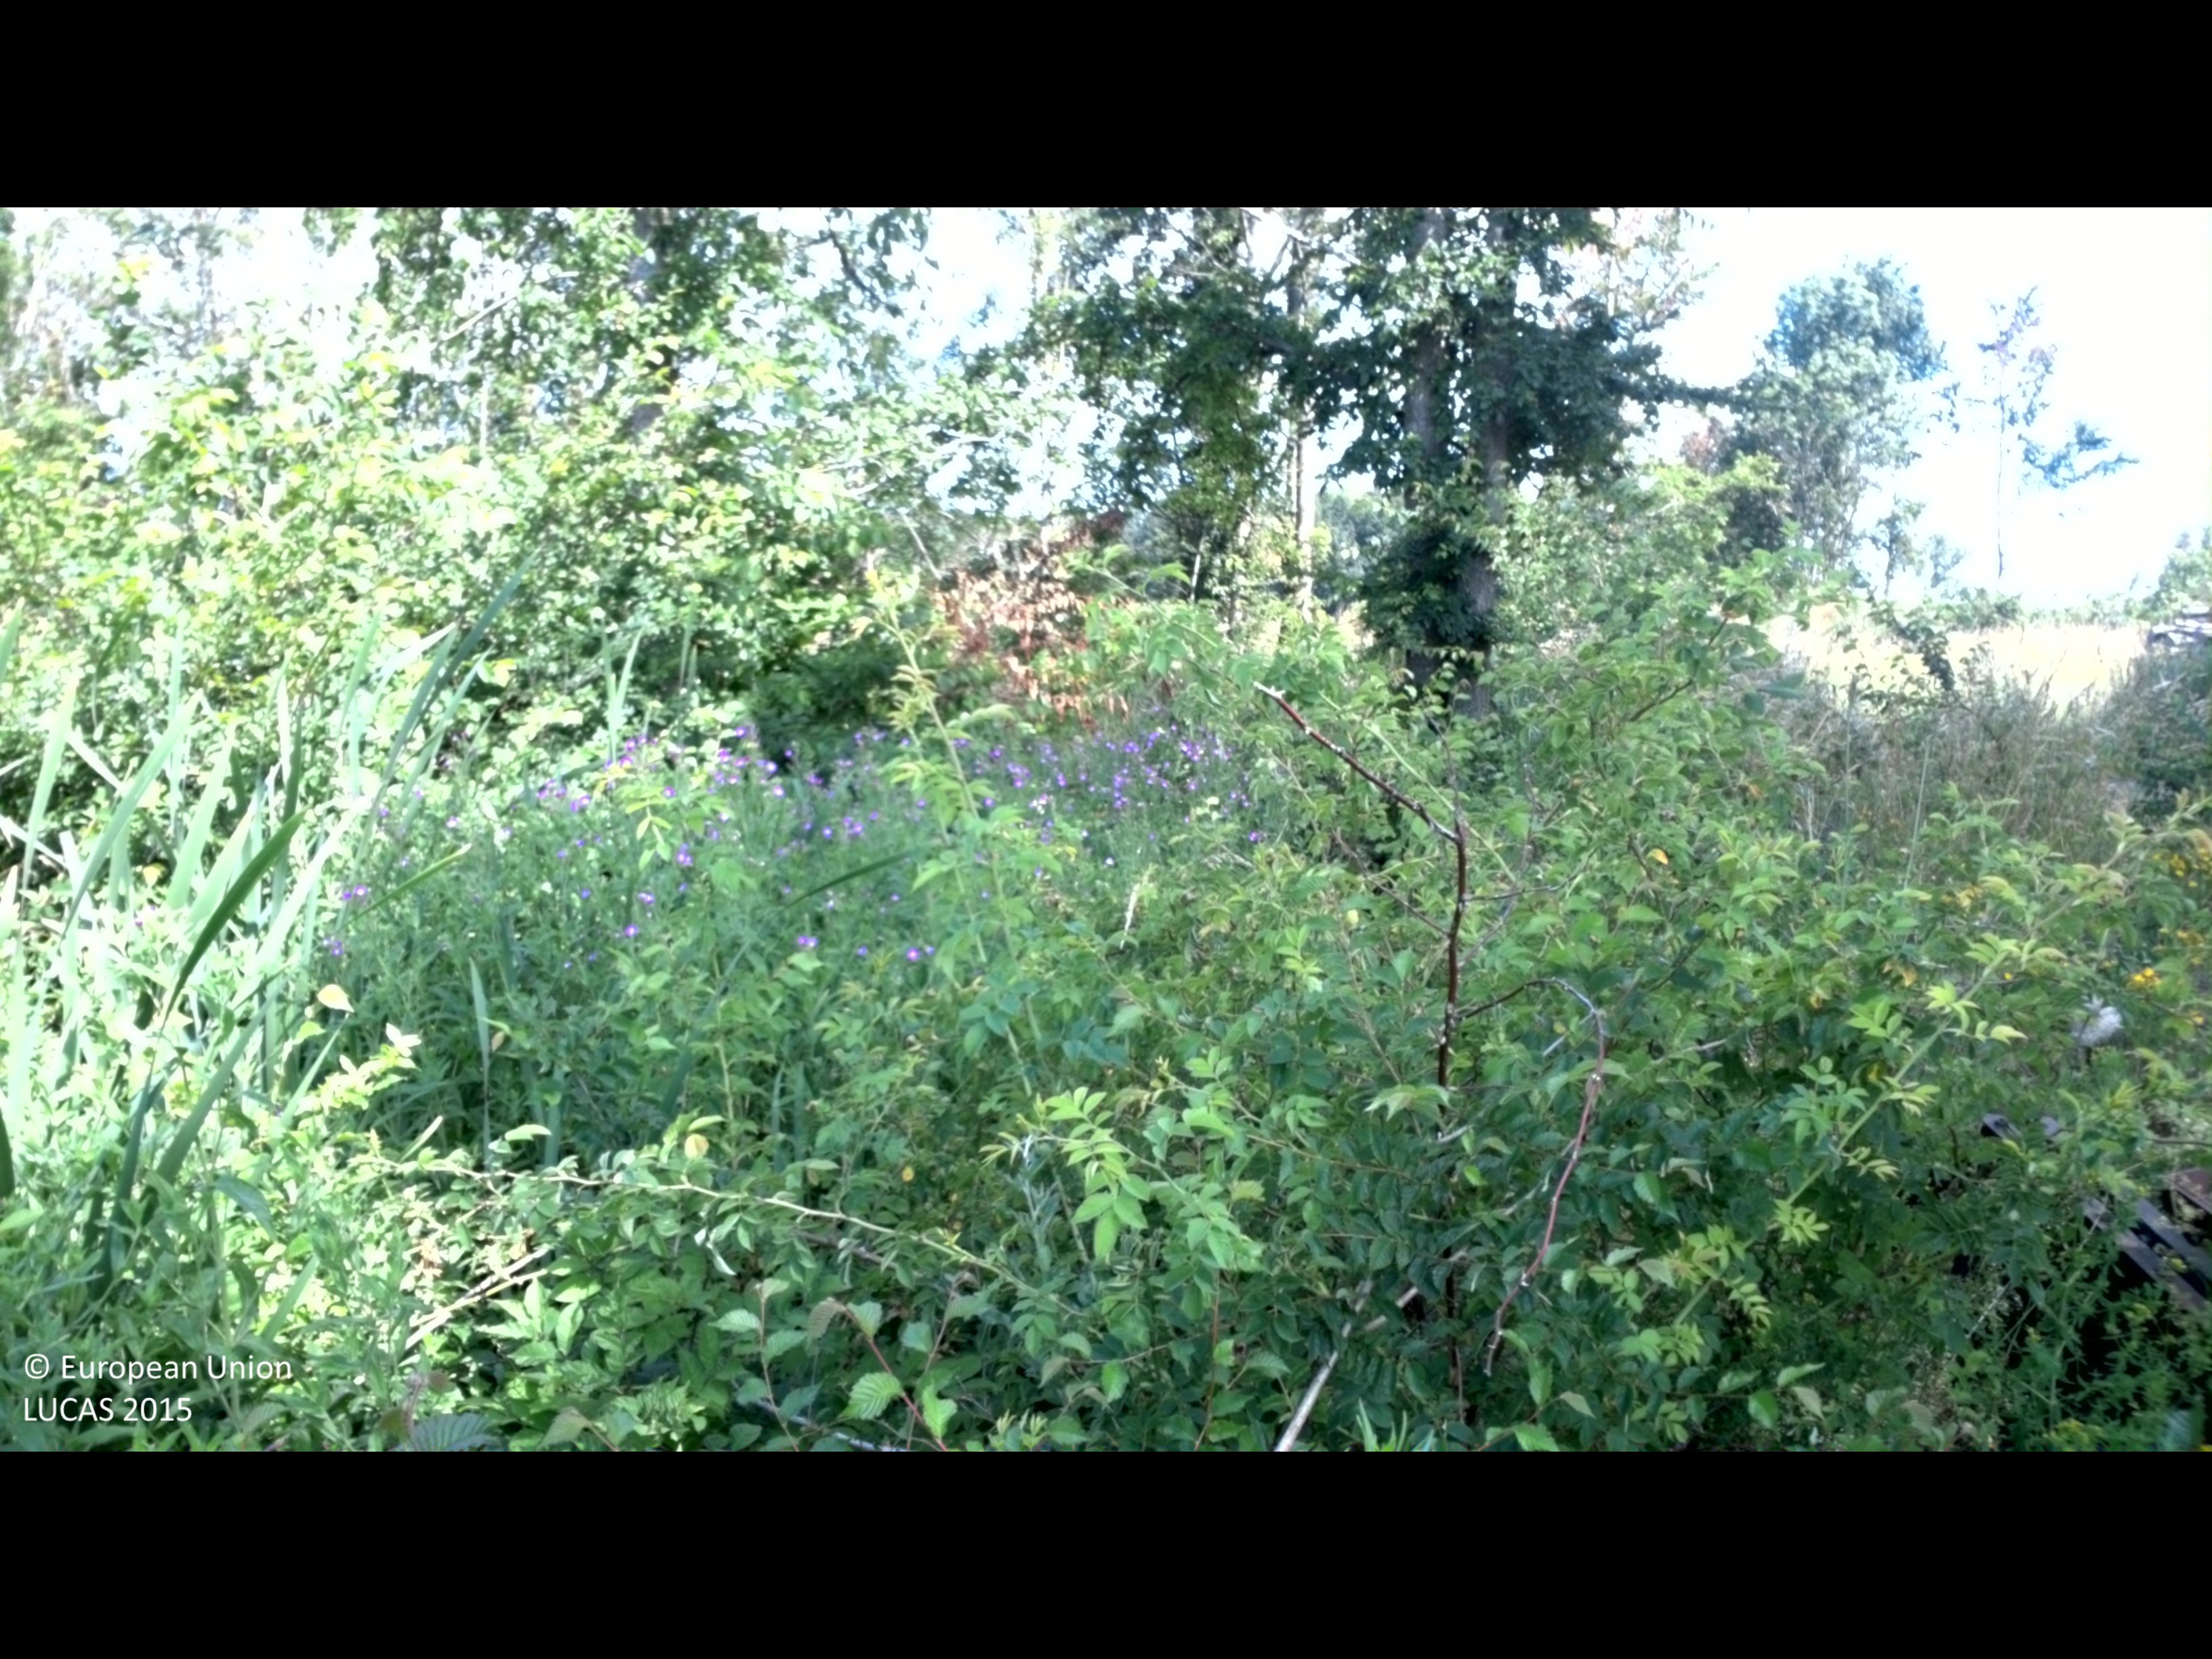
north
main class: Woodland
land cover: Broadleaved woodland
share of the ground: > 75 %
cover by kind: broadleaved forest trees 75 %, shrubs 20 %, herbaceous plants 5 %
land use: Semi-natural and natural areas not in use
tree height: > 5 m
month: July
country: SE
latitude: 56.4768
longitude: 16.4471
